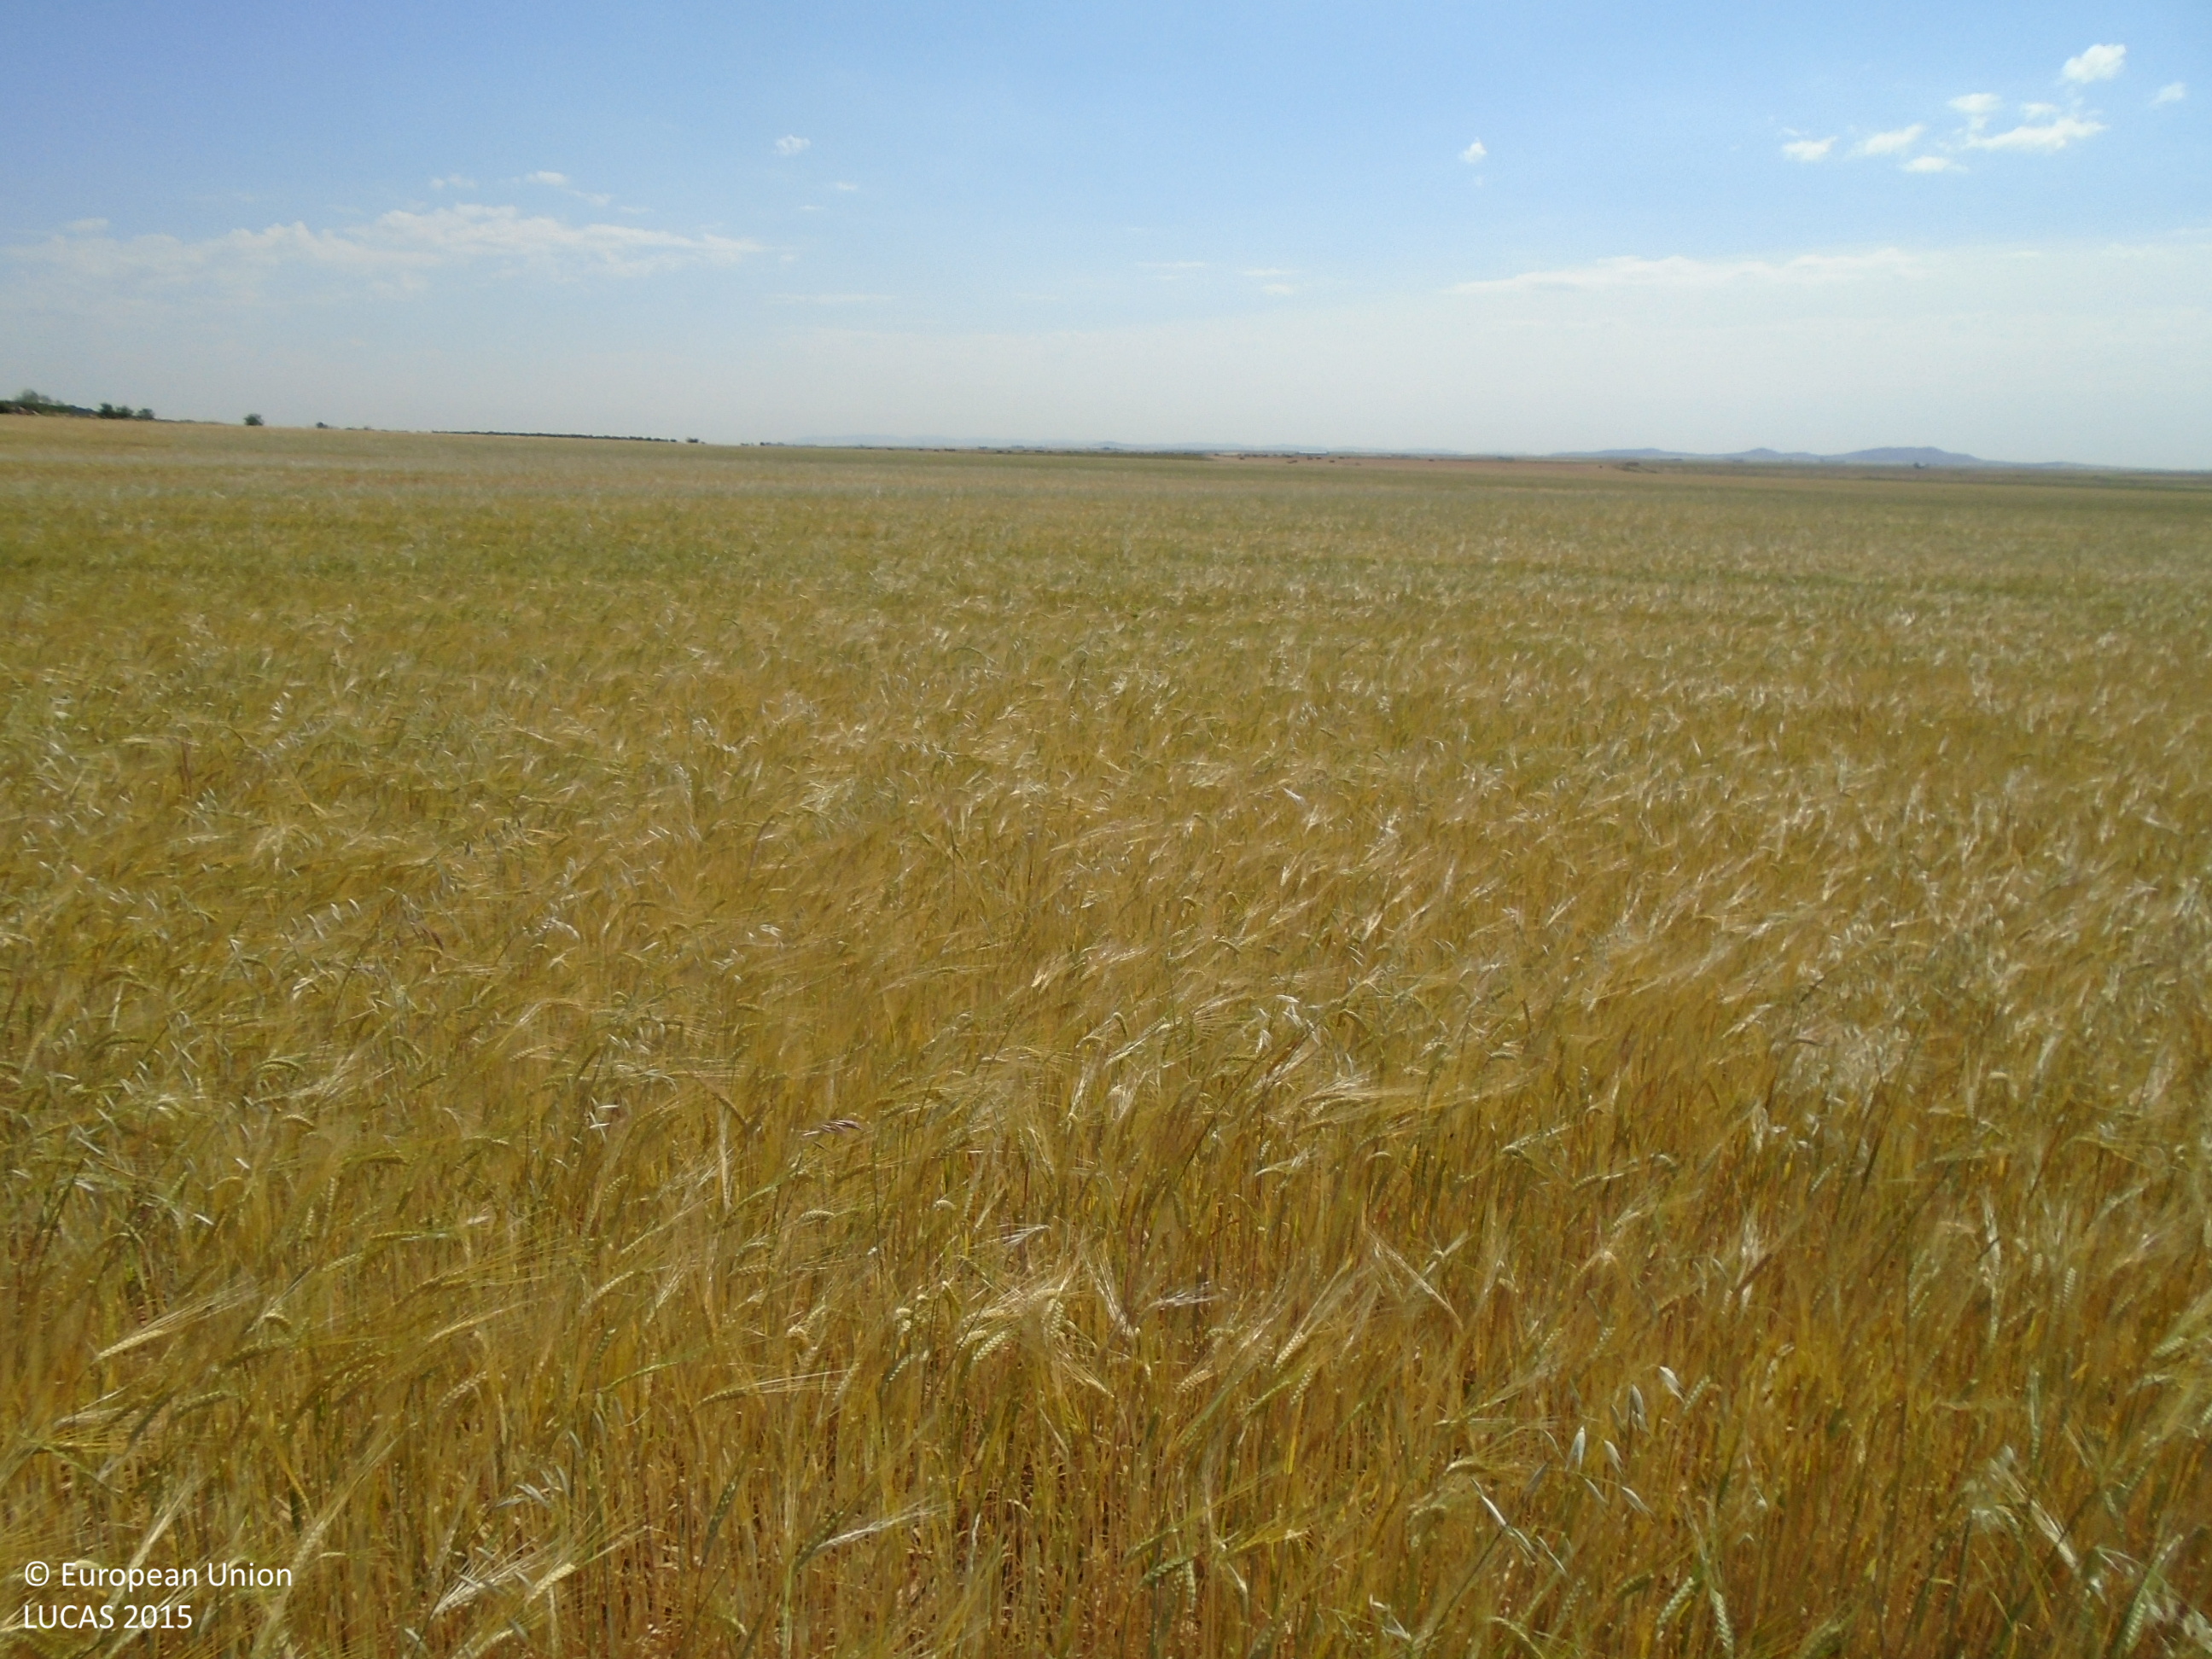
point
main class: Cropland
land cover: Barley
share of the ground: > 75 %
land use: Agriculture (excluding fallow land and kitchen gardens)
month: May
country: ES
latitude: 39.5511
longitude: -3.7470
